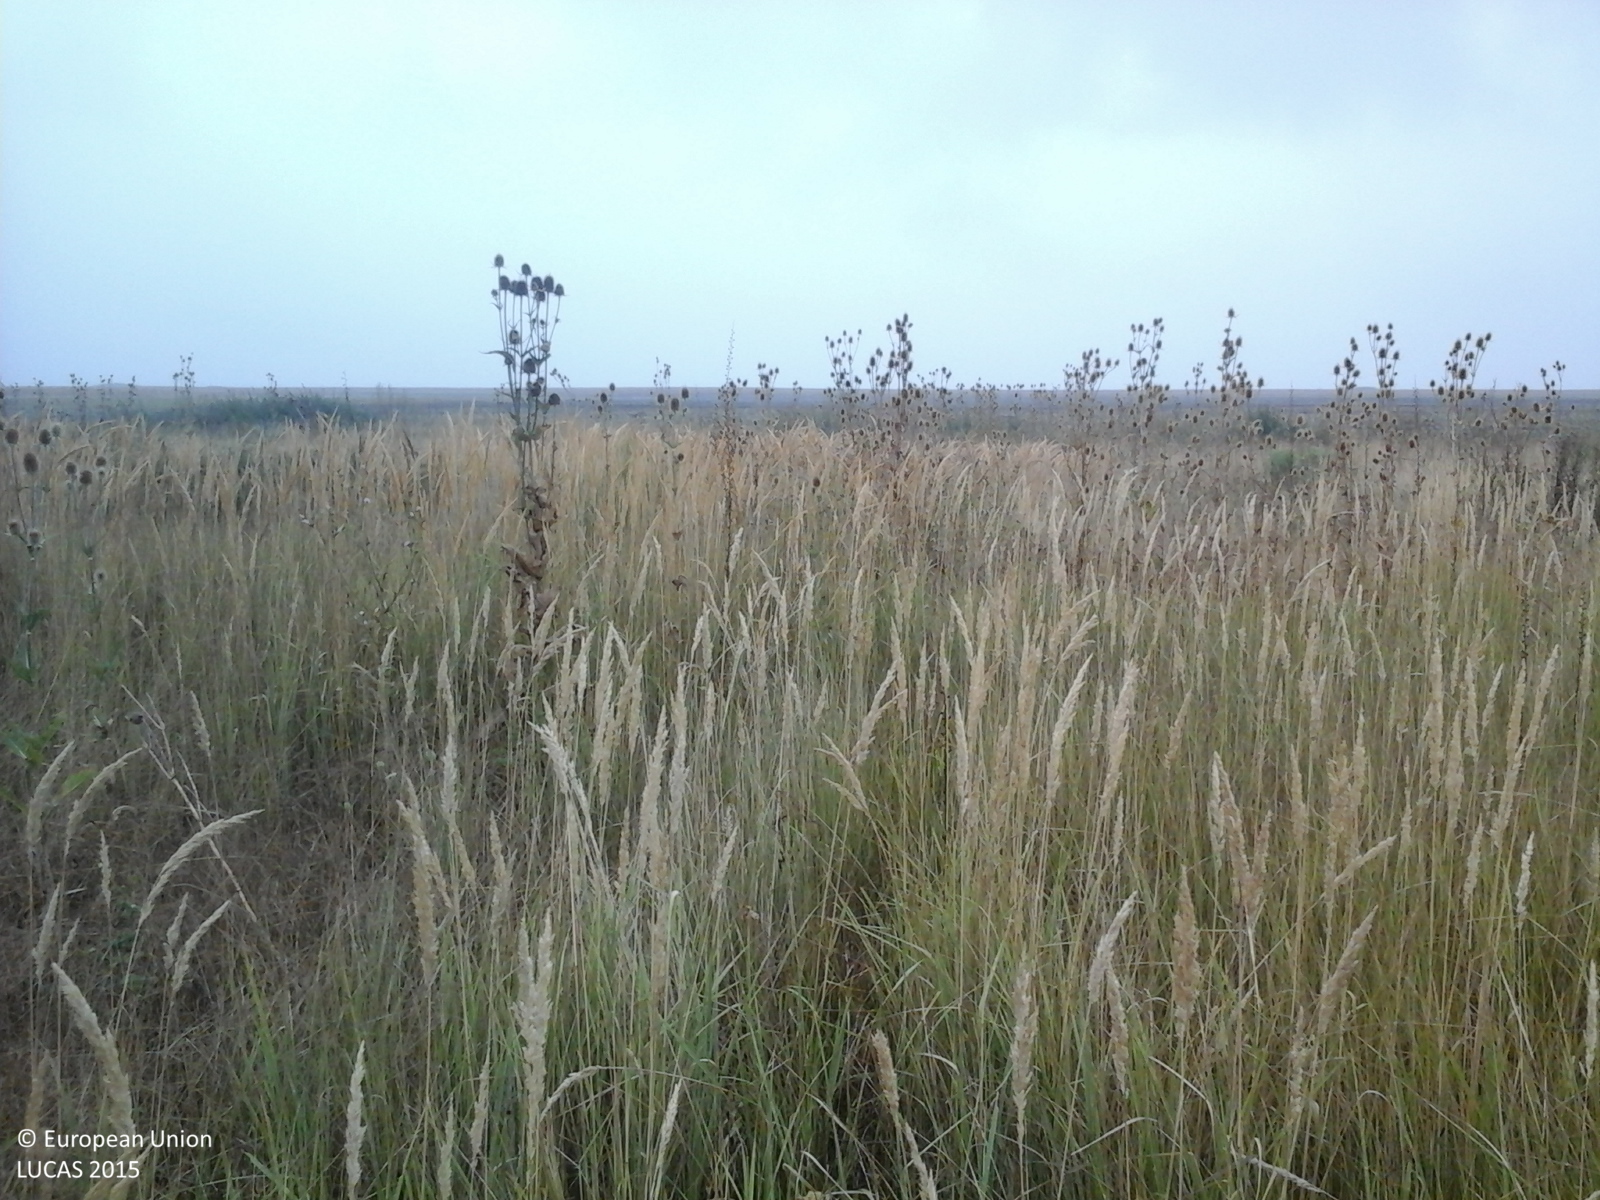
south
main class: Grassland
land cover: Spontaneously vegetated surfaces
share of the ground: > 75 %
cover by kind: herbaceous plants 100 %
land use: Fallow land
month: August
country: RO
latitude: 46.0701
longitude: 20.8495
